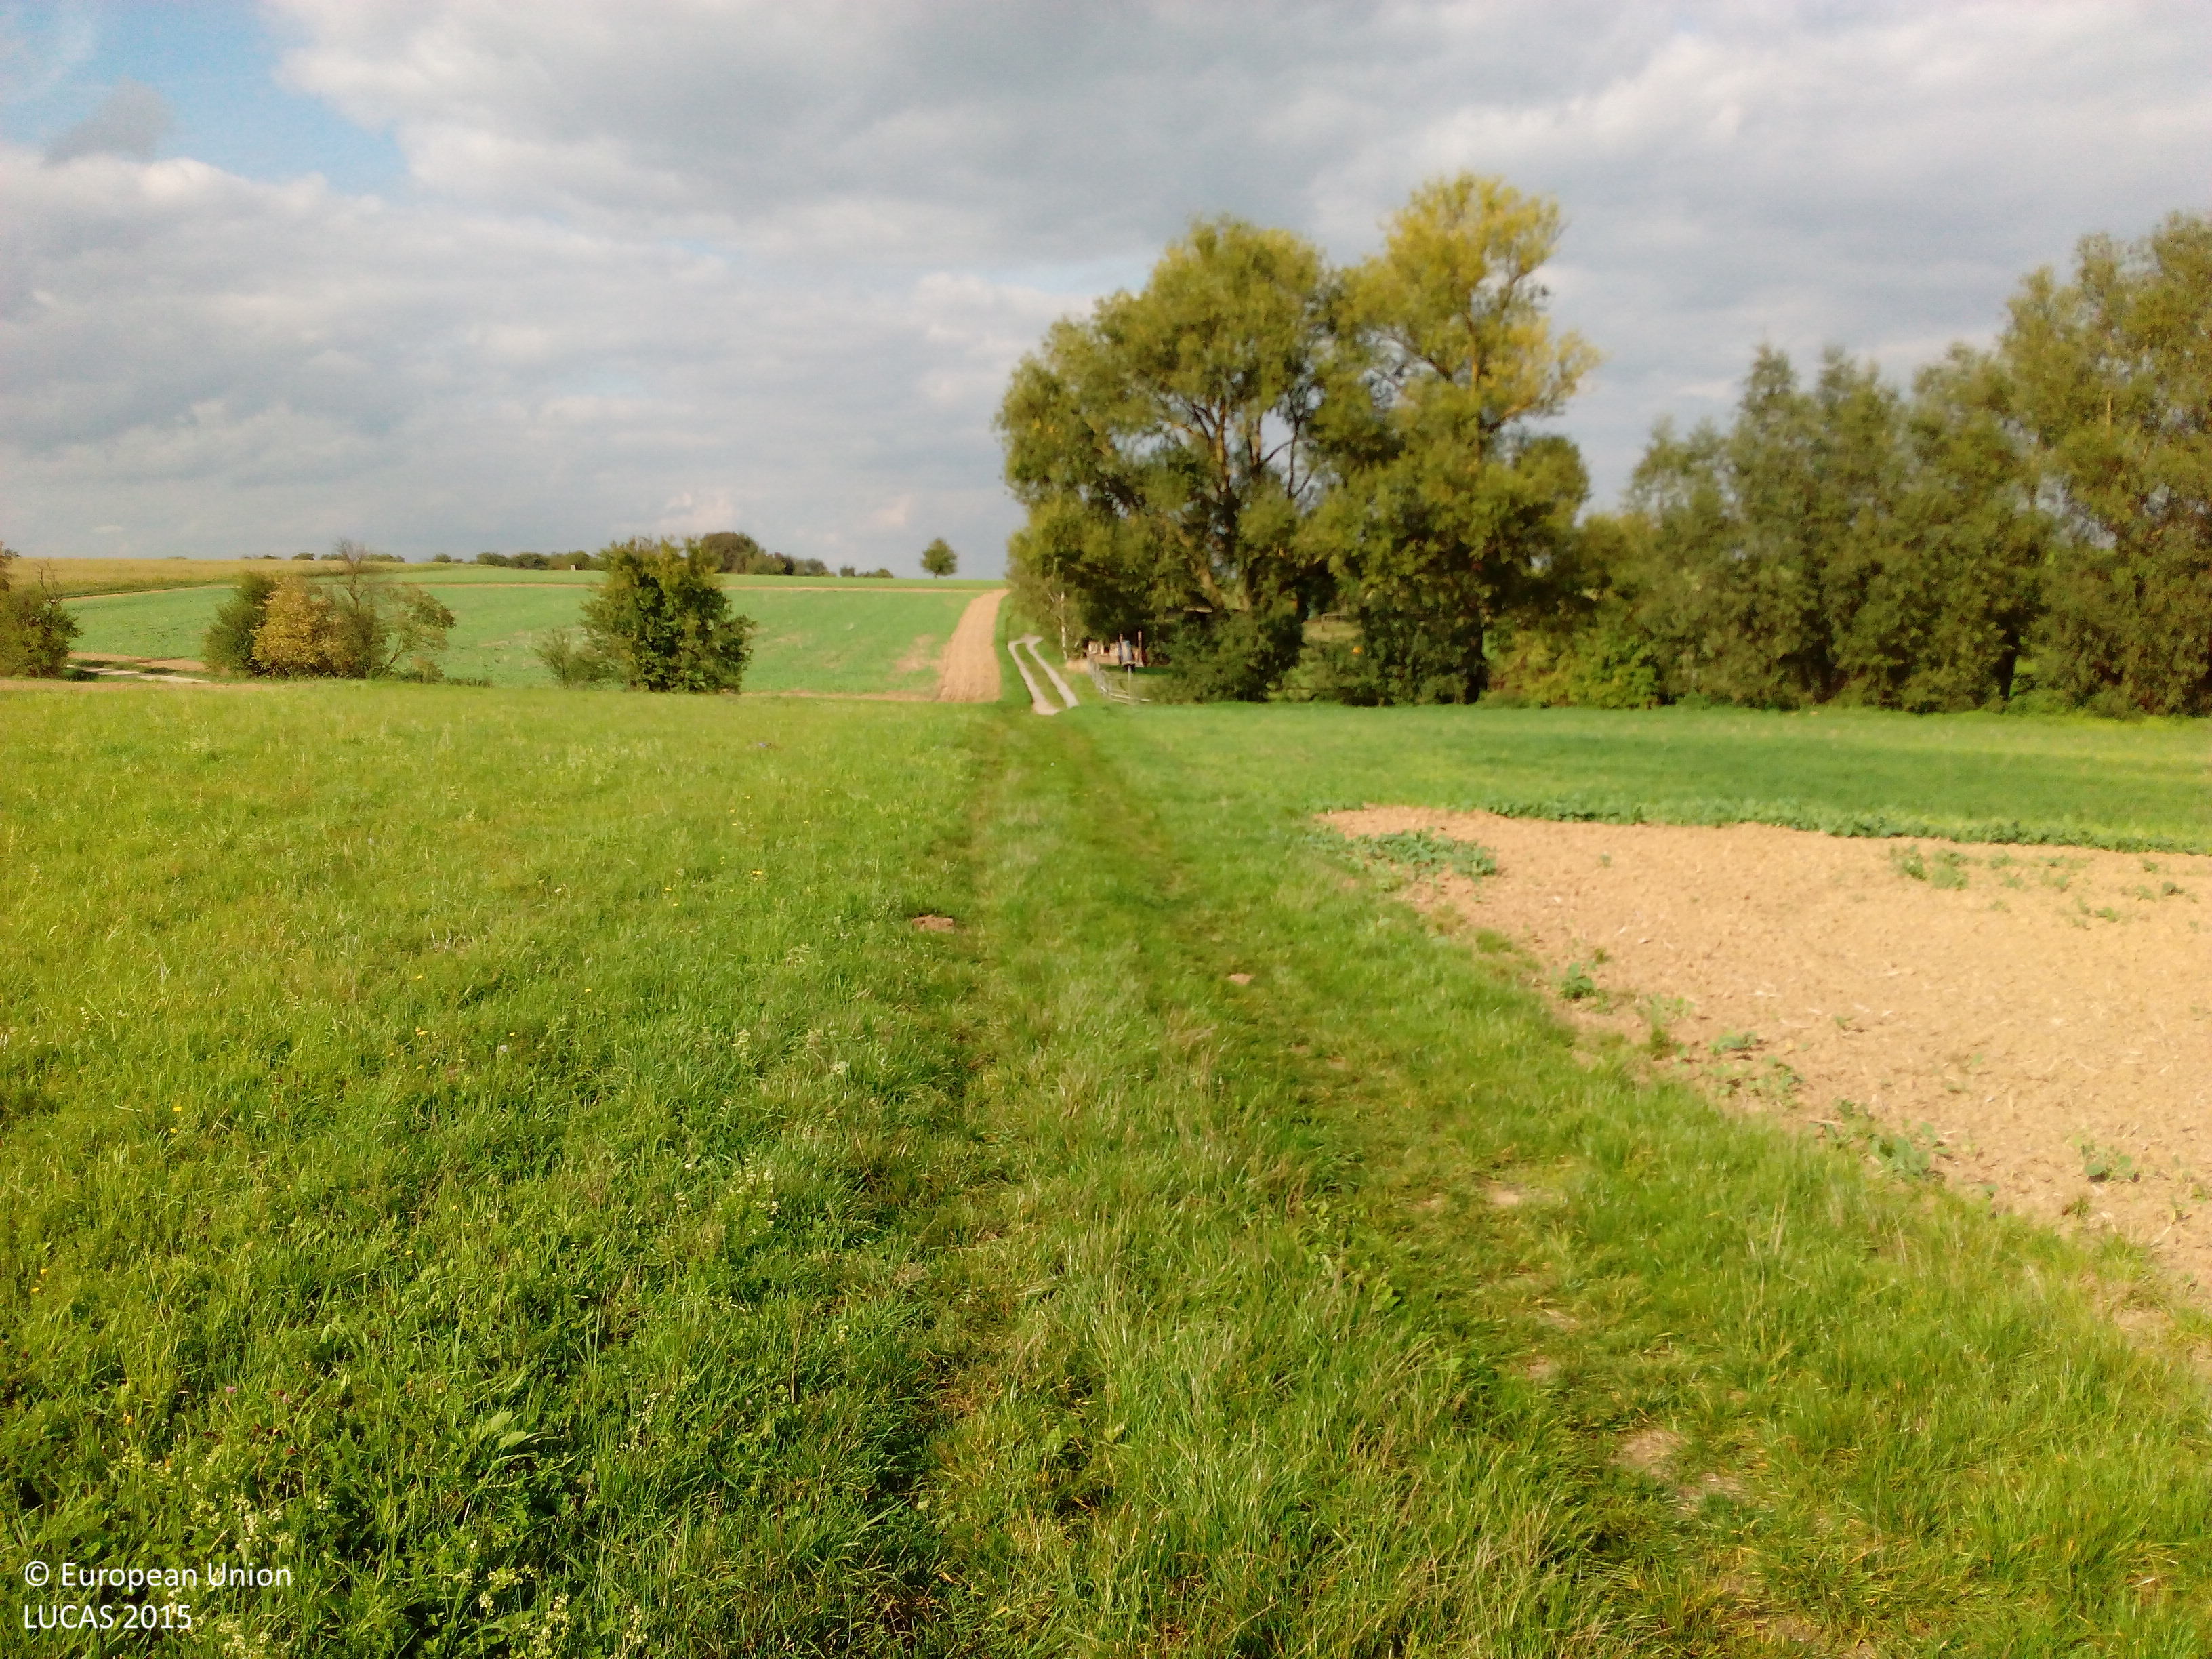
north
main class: Cropland
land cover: Rape and turnip rape
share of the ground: < 10 %
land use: Agriculture (excluding fallow land and kitchen gardens)
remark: Harvested field
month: September
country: DE
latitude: 50.4994
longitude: 8.6046
